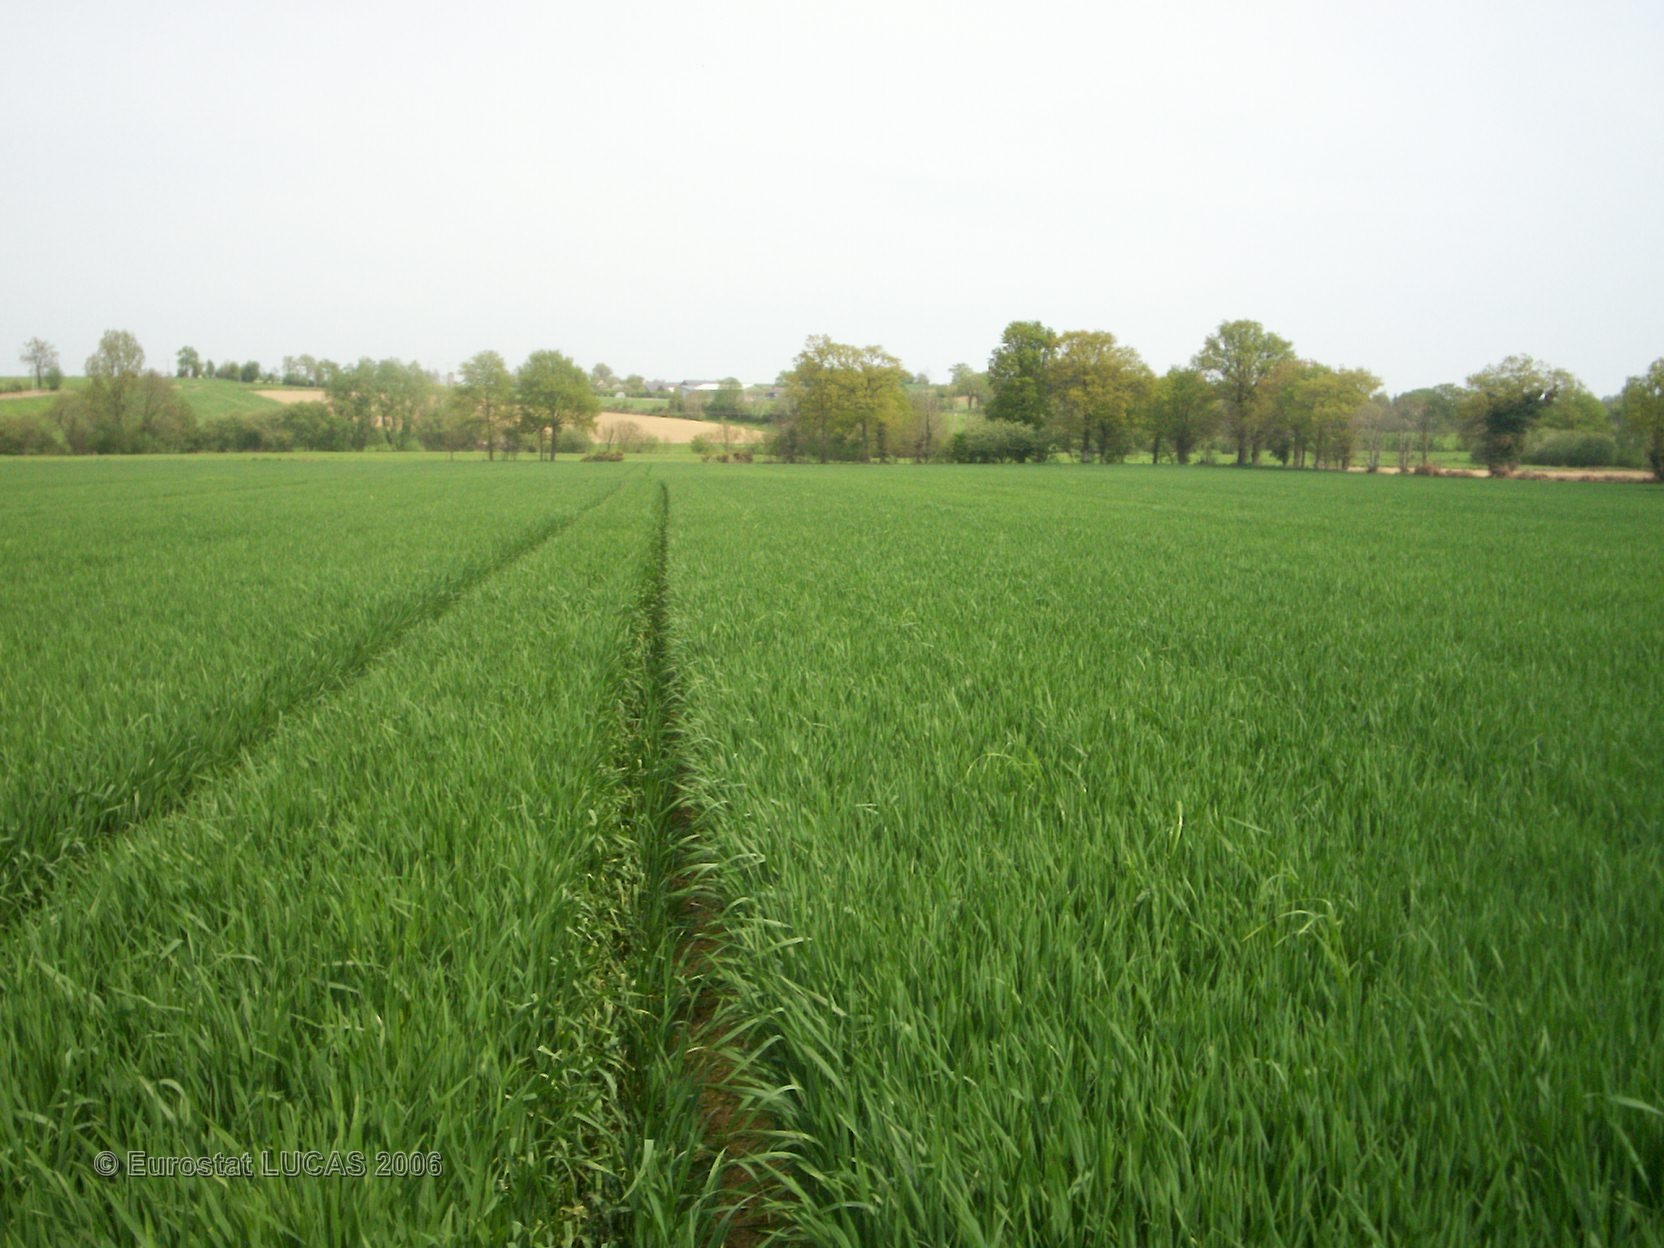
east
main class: Cropland
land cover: Common wheat
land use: Agriculture (excluding fallow land and kitchen gardens)
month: May
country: FR
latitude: 47.9135
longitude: -1.2949
